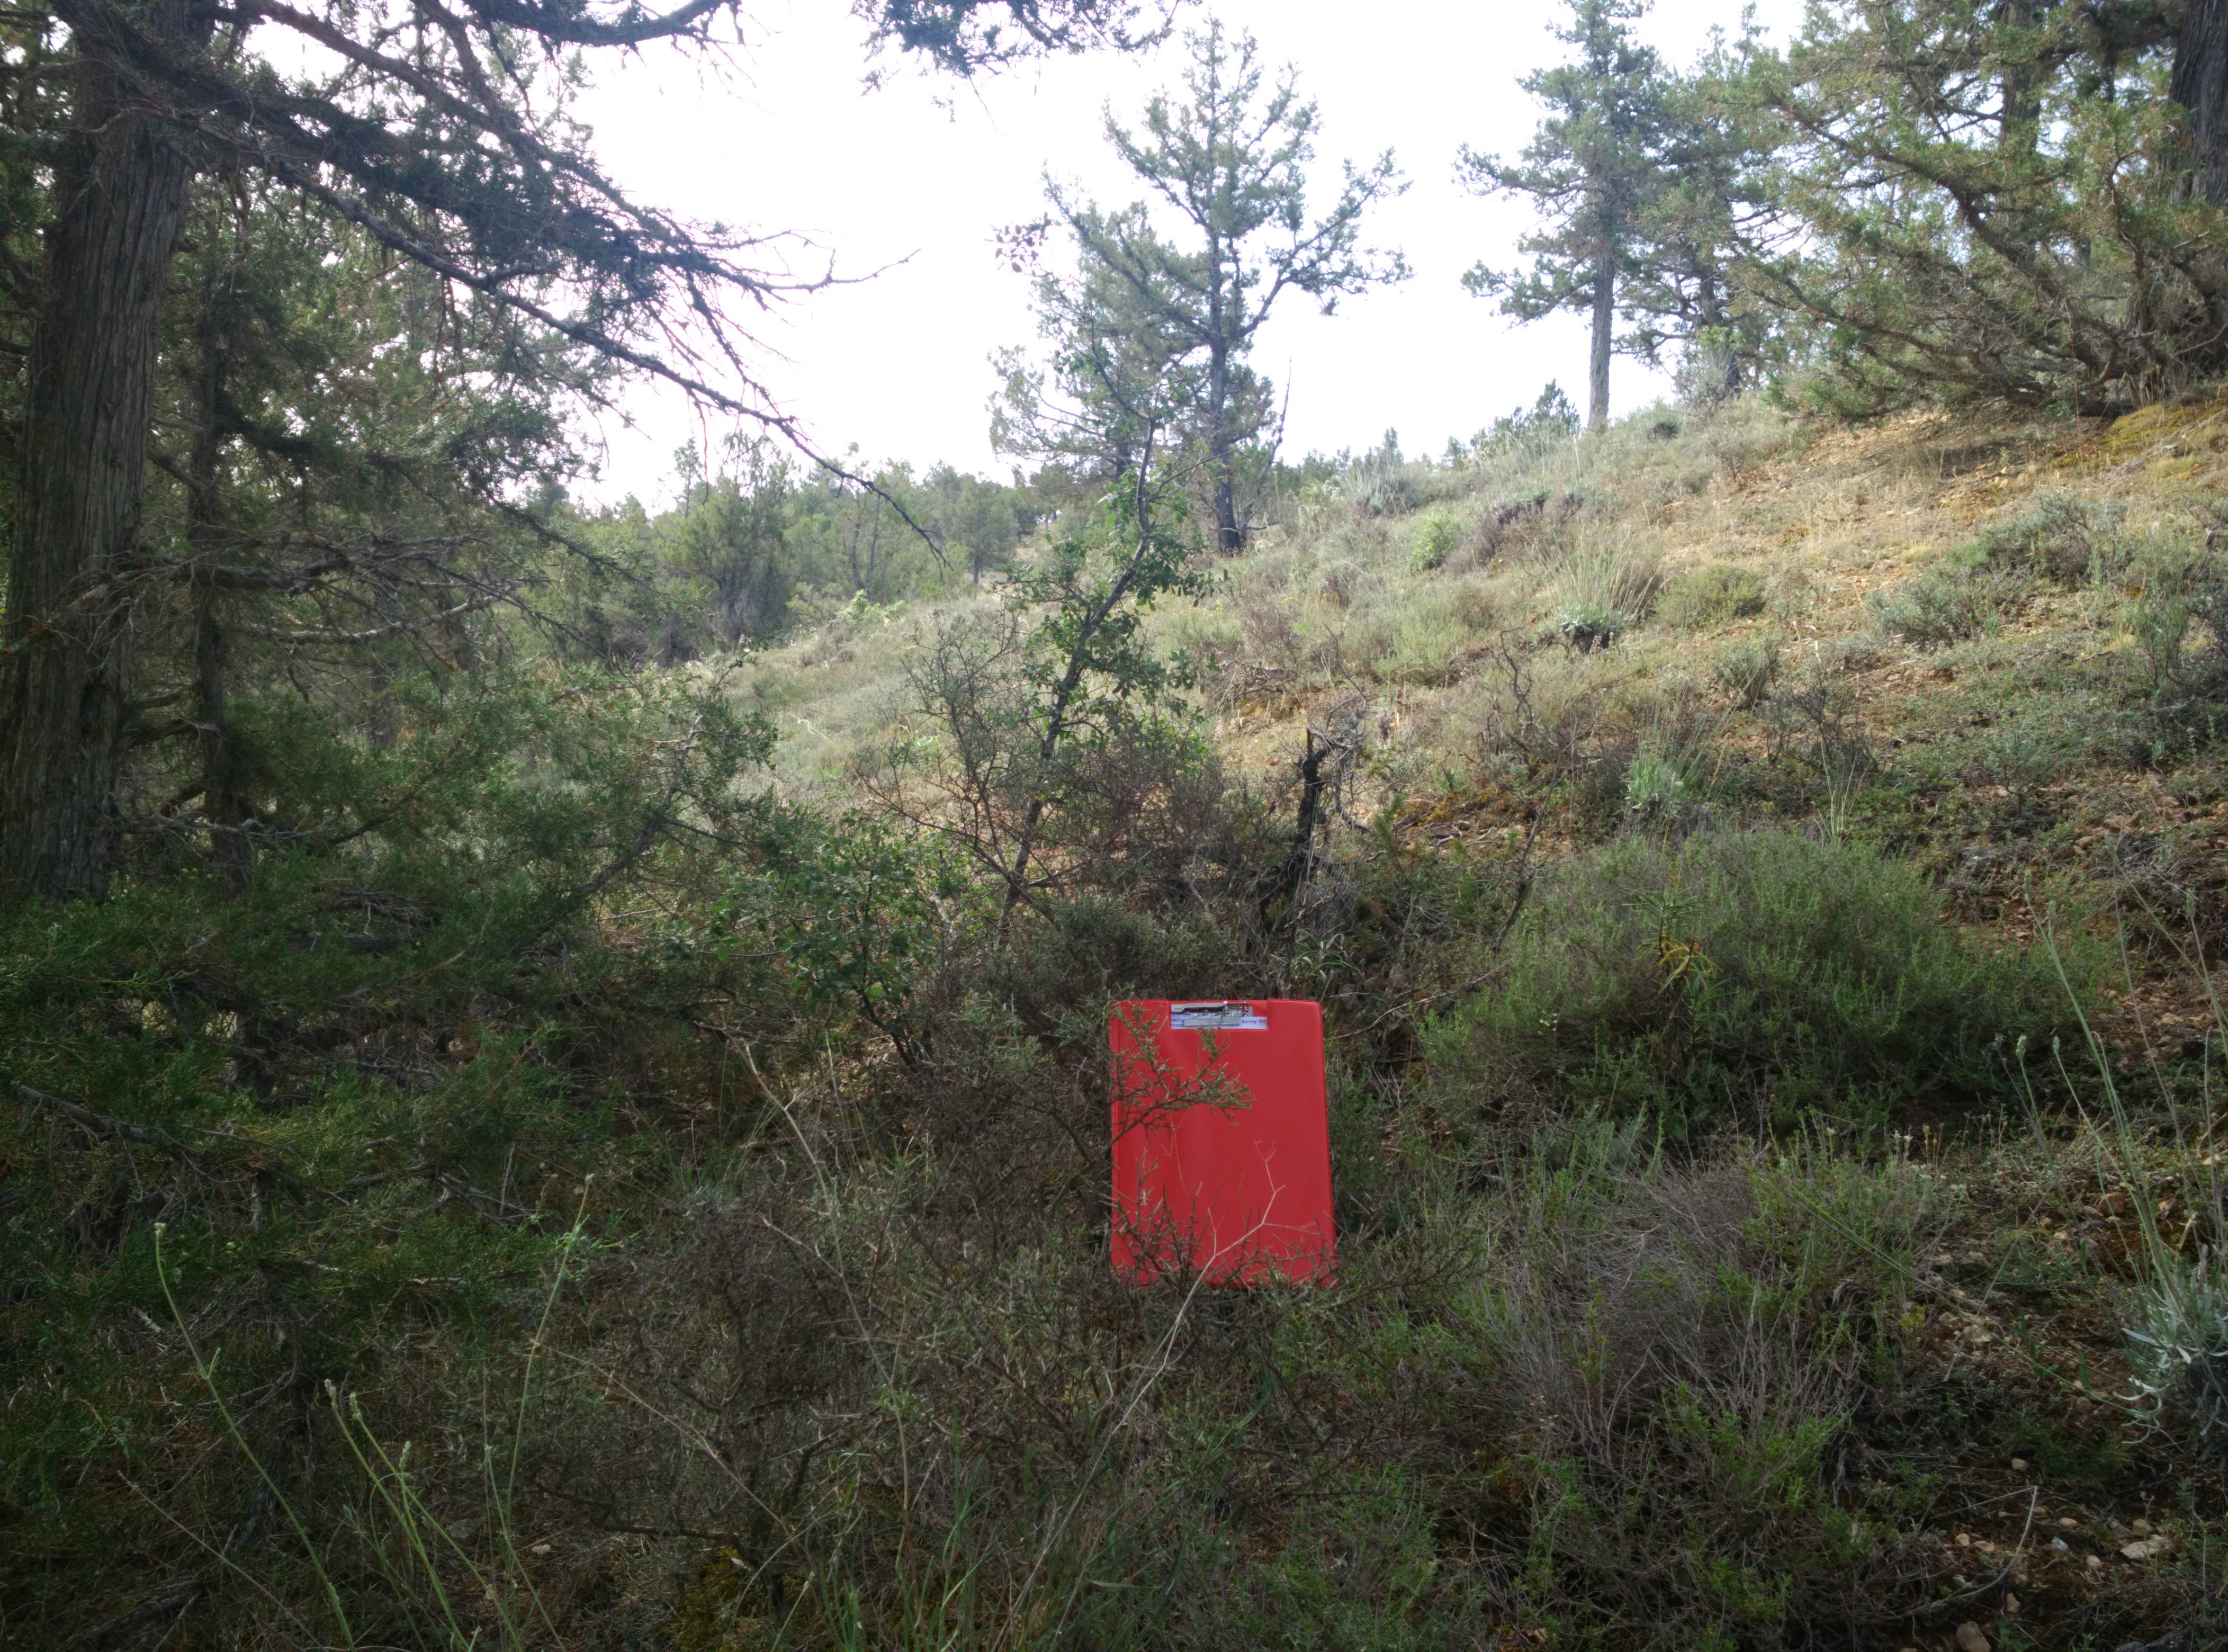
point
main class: Woodland
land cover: Other coniferous woodland
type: coniferous forest of the mediterranean region
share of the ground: 25 - 50 %
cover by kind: herbaceous plants 50 %, coniferous forest trees 30 %, shrubs 10 %, unconsolidated bare surface 10 %
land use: Semi-natural and natural areas not in use
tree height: > 5 m
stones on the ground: 10 - 25 %
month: July
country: ES
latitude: 40.8827
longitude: -1.9740
